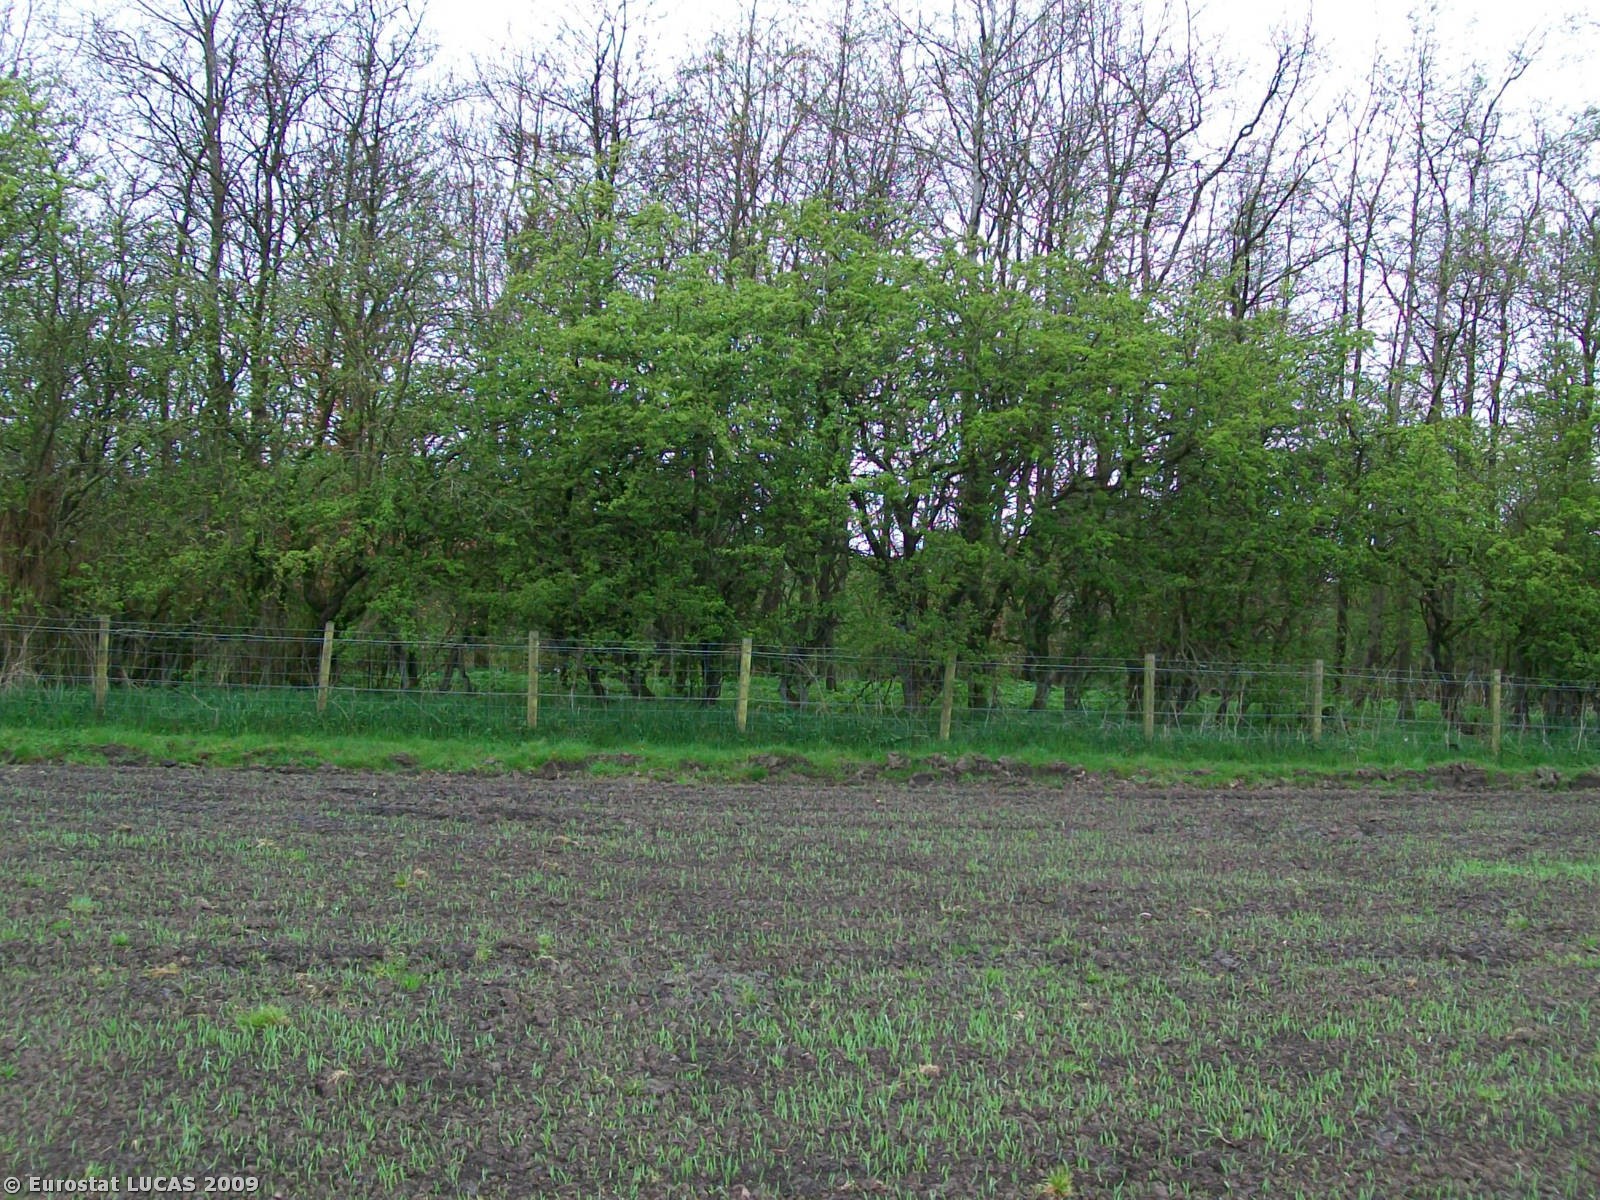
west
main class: Cropland
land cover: Barley
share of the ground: > 75 %
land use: Agriculture (excluding fallow land and kitchen gardens)
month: April
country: GB
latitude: 55.8562
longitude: -3.6437
